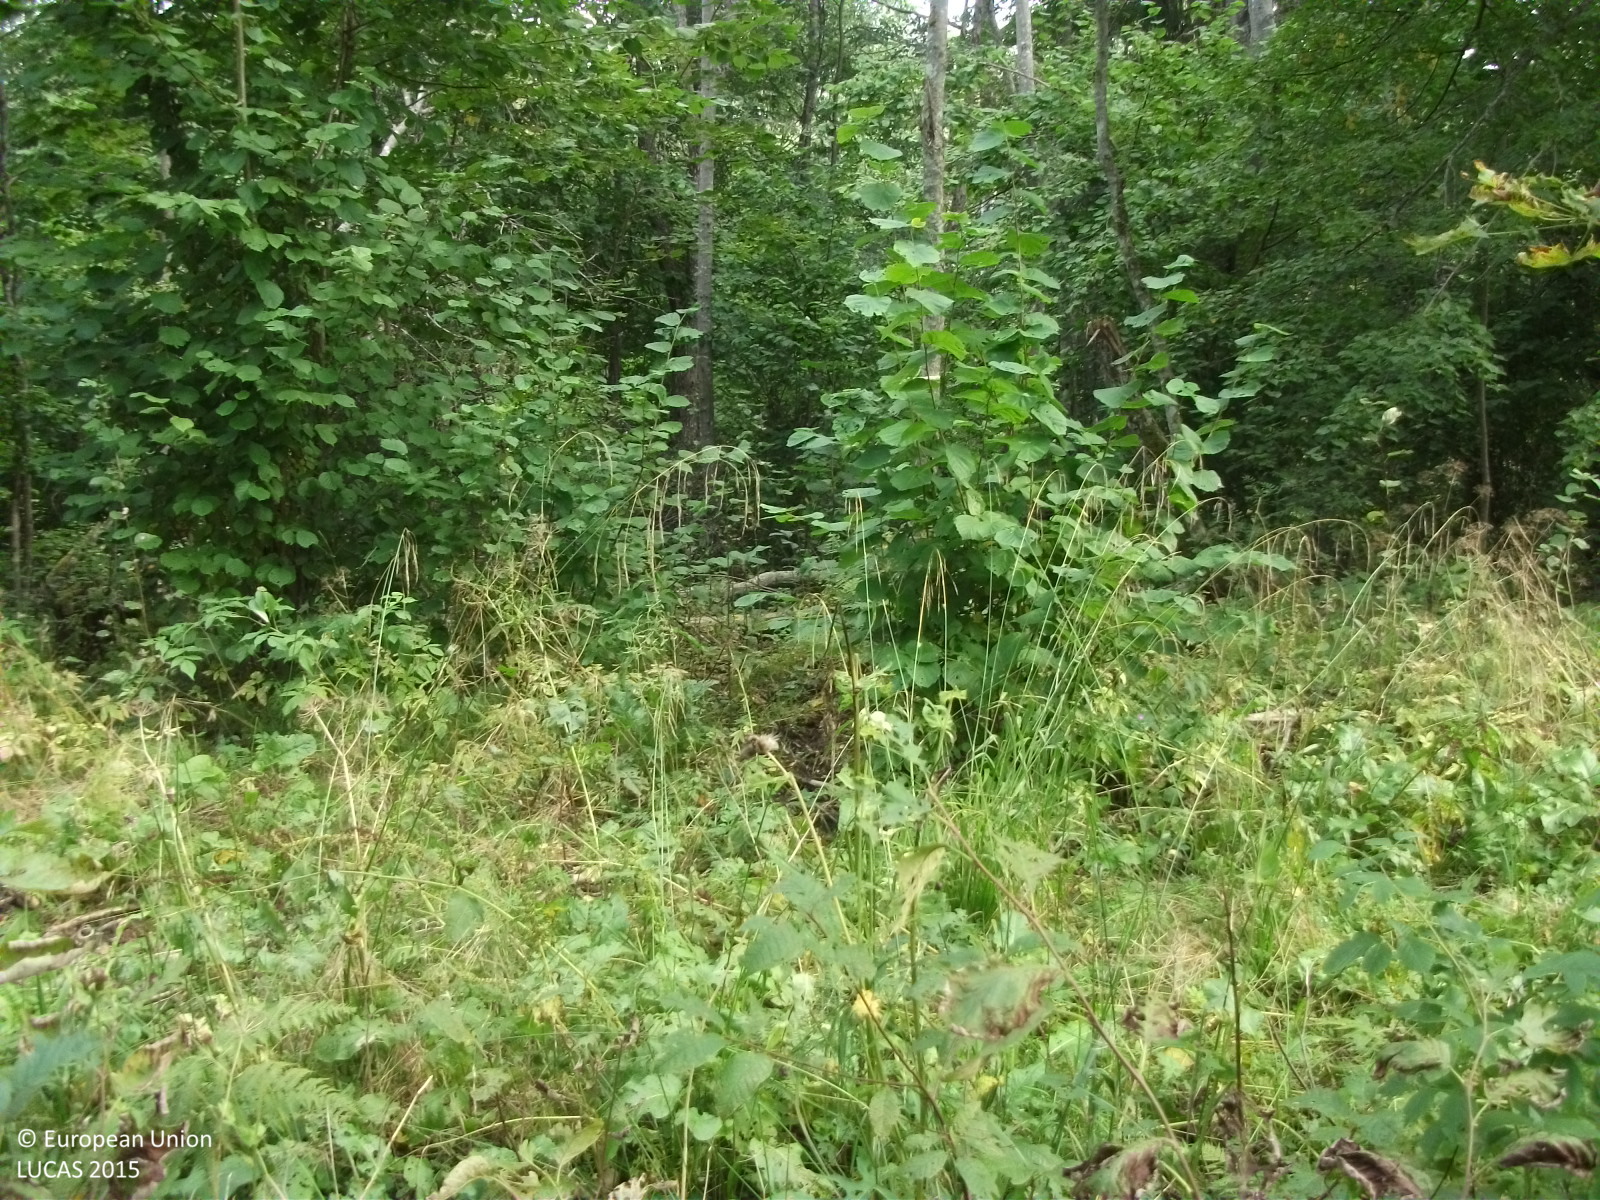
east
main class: Woodland
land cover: Broadleaved woodland
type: non-riverine alder, birch or aspen forest
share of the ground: 50 - 75 %
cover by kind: broadleaved forest trees 70 %, shrubs 20 %, coniferous forest trees 5 %, herbaceous plants 5 %
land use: Semi-natural and natural areas not in use
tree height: > 5 m
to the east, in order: Broadleaved woodland; Inland fresh running water; Spruce dominated mixed woodland; Broadleaved woodland
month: September
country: LV
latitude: 57.9139
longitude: 24.9005
